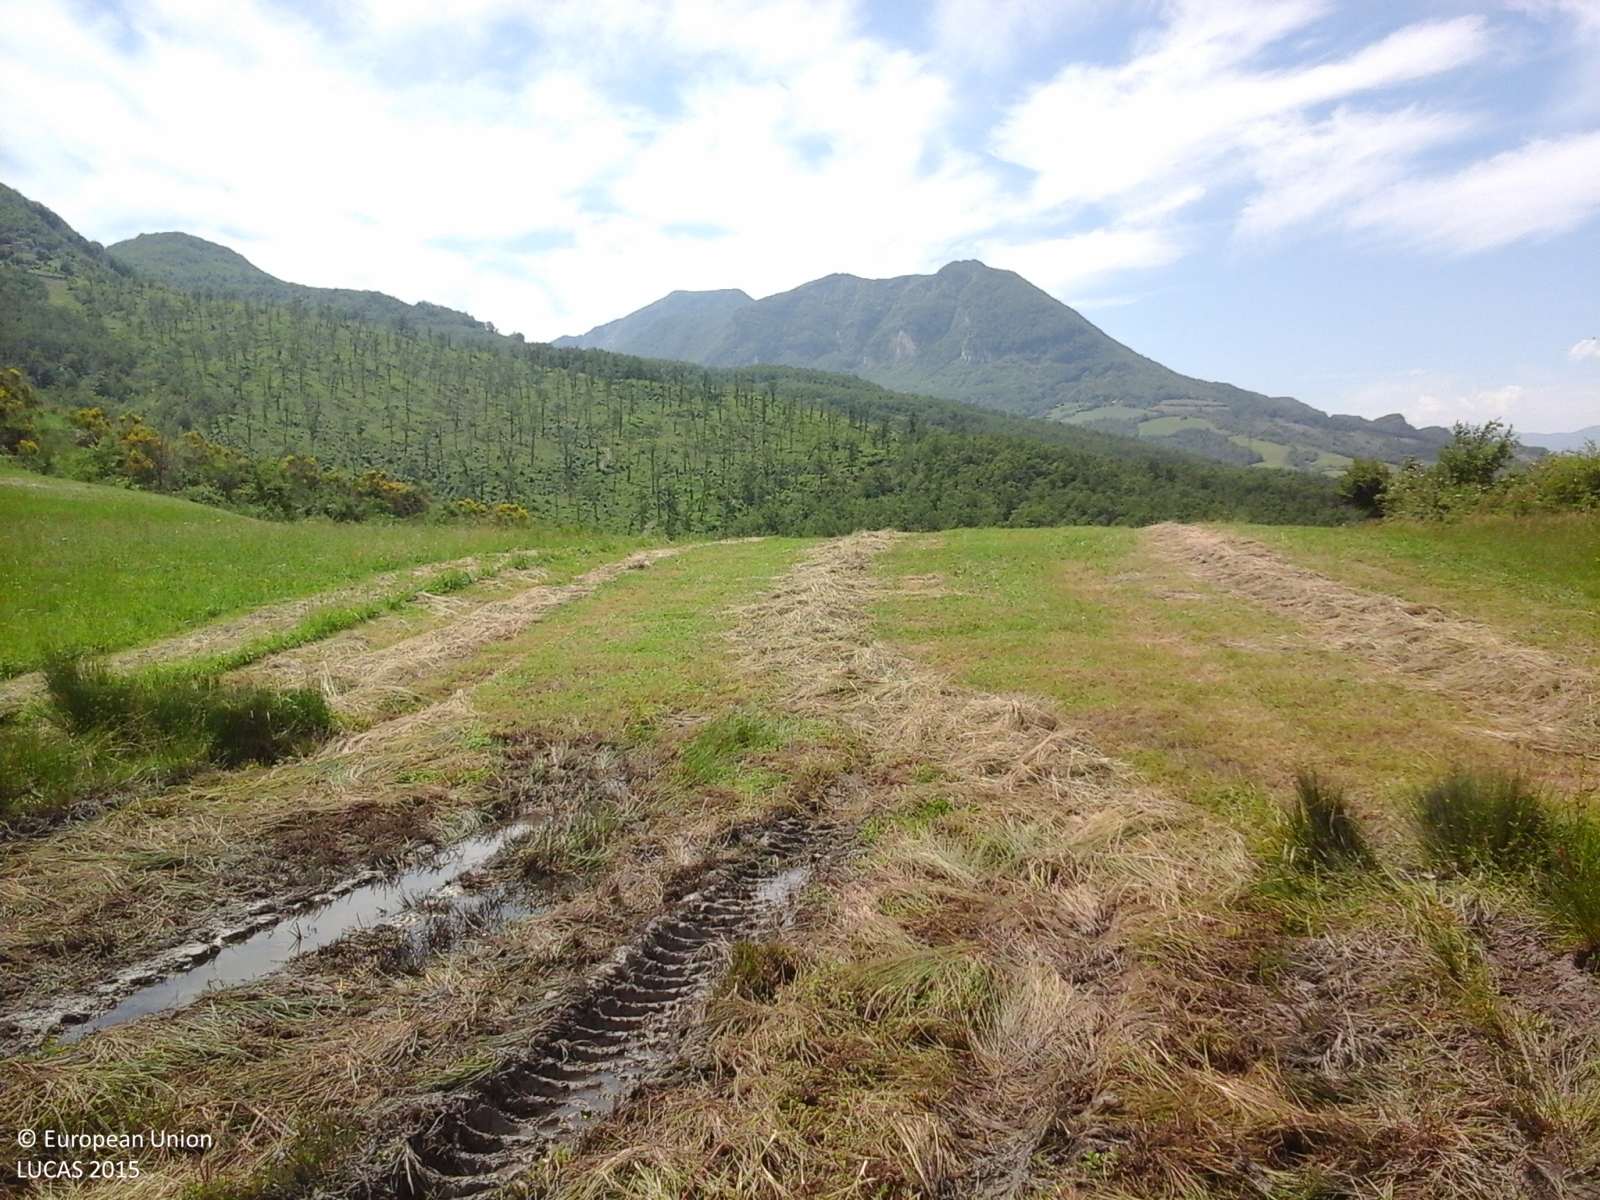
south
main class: Grassland
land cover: Grassland without tree/shrub cover
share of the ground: > 75 %
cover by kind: herbaceous plants 100 %
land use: Agriculture (excluding fallow land and kitchen gardens)
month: May
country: IT
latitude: 44.2544
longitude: 11.1121
